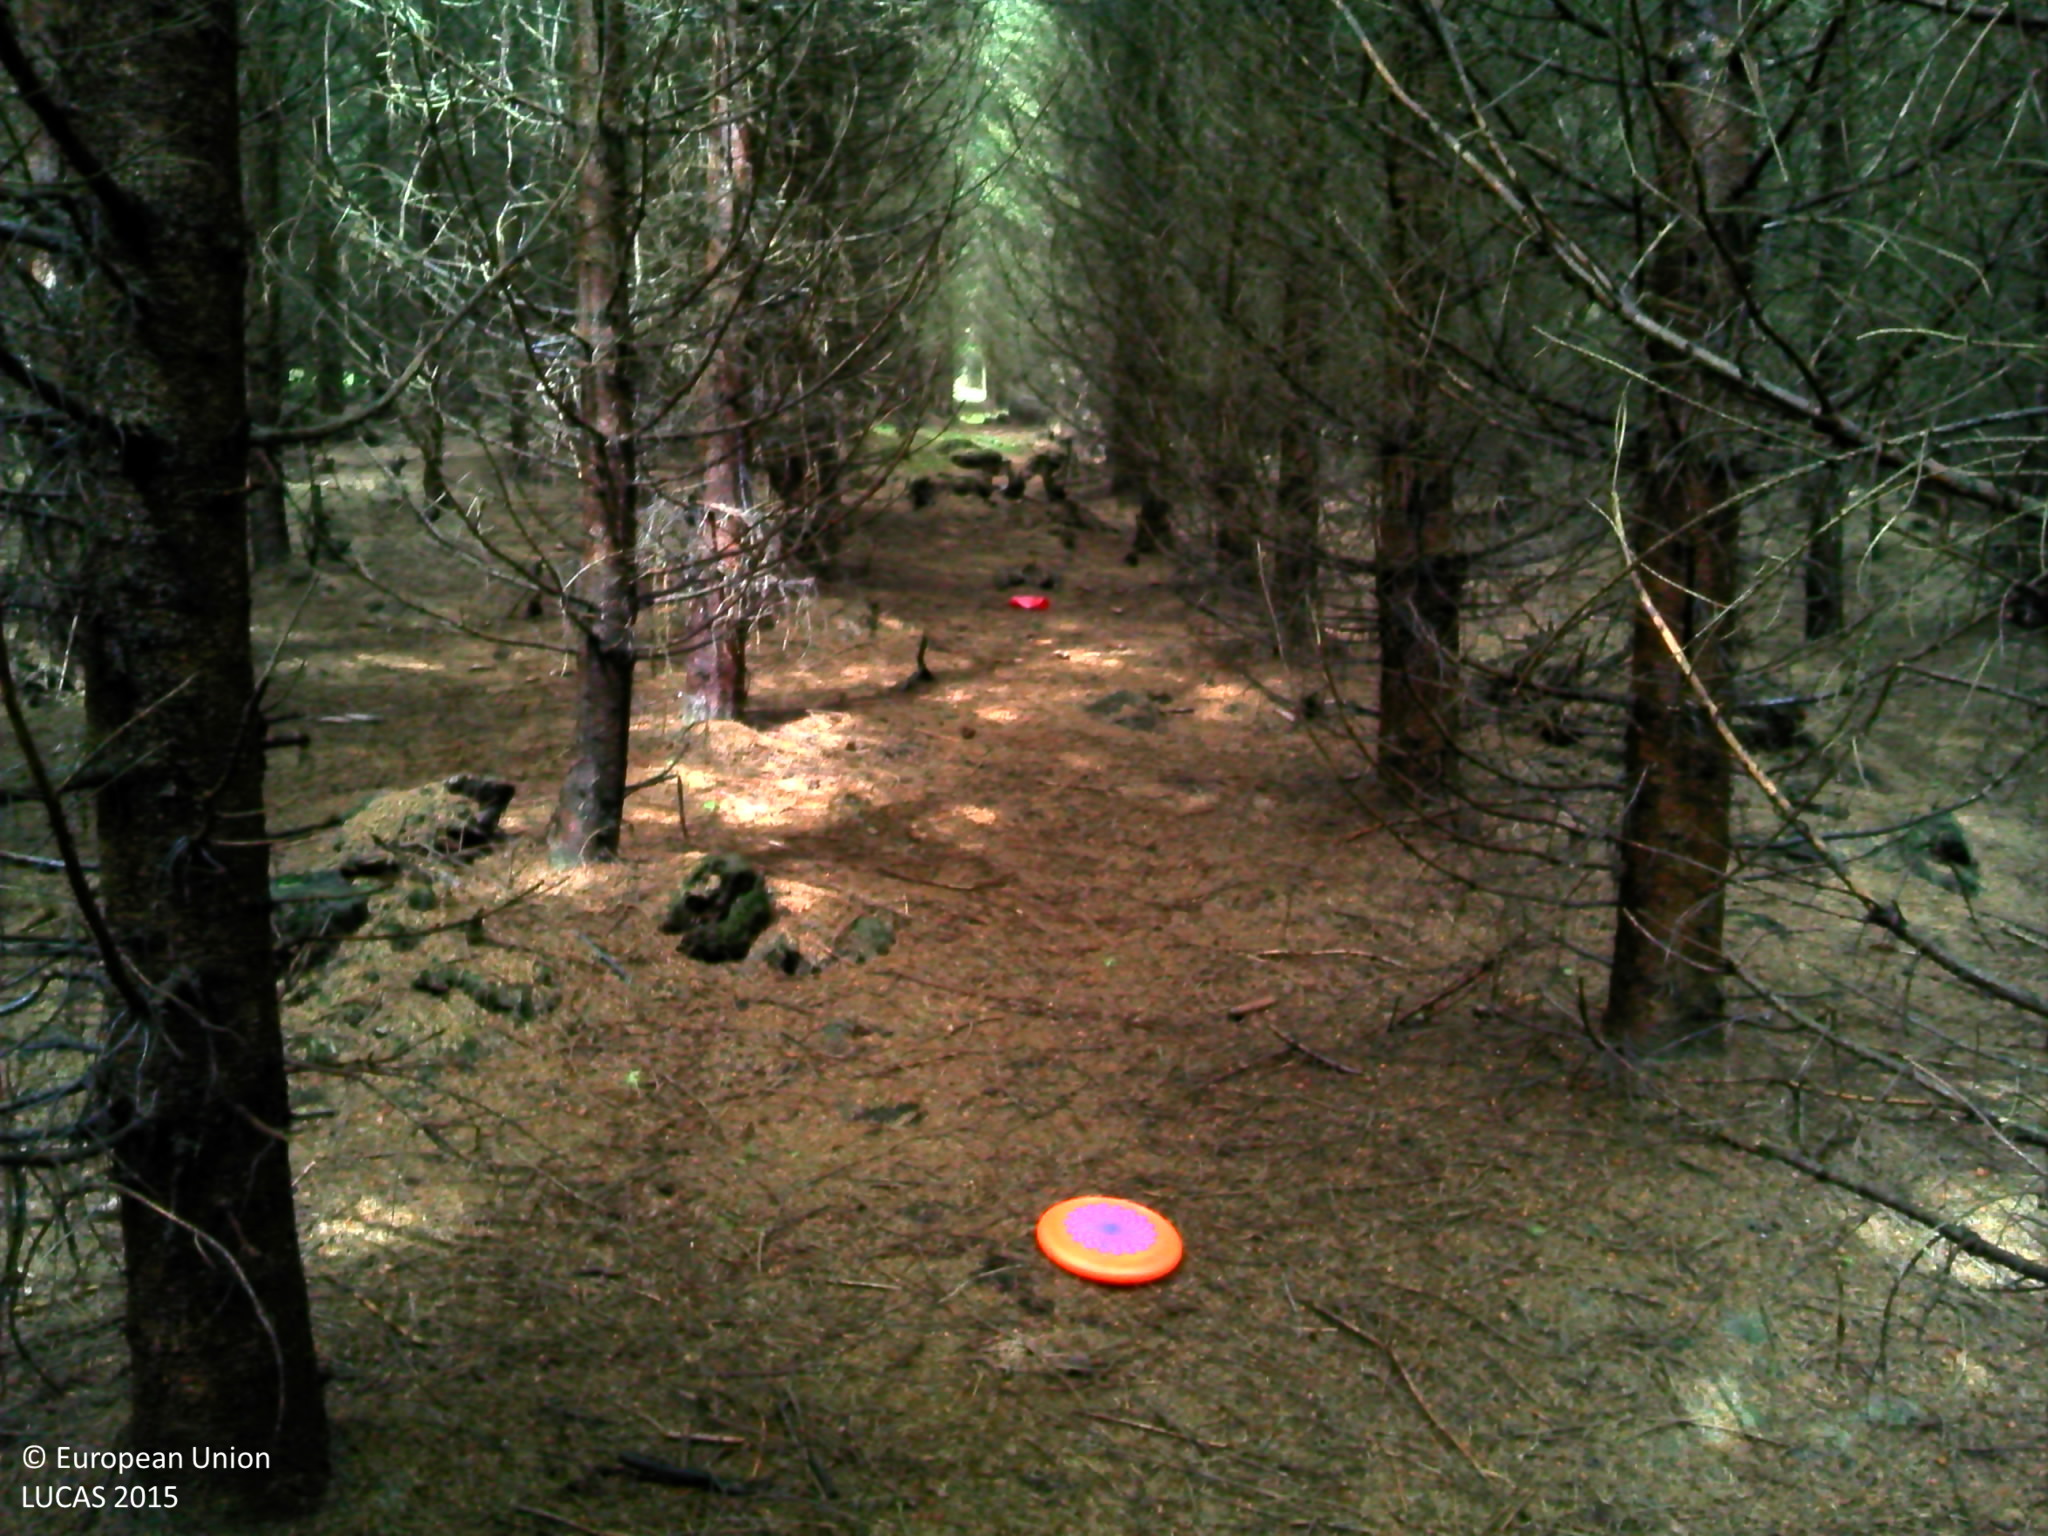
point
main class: Woodland
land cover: Spruce dominated coniferous woodland
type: alpine coniferous forest
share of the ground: > 75 %
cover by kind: coniferous forest trees 100 %
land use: Forestry
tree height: > 5 m
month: June
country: BE
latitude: 50.2987
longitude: 5.6325
